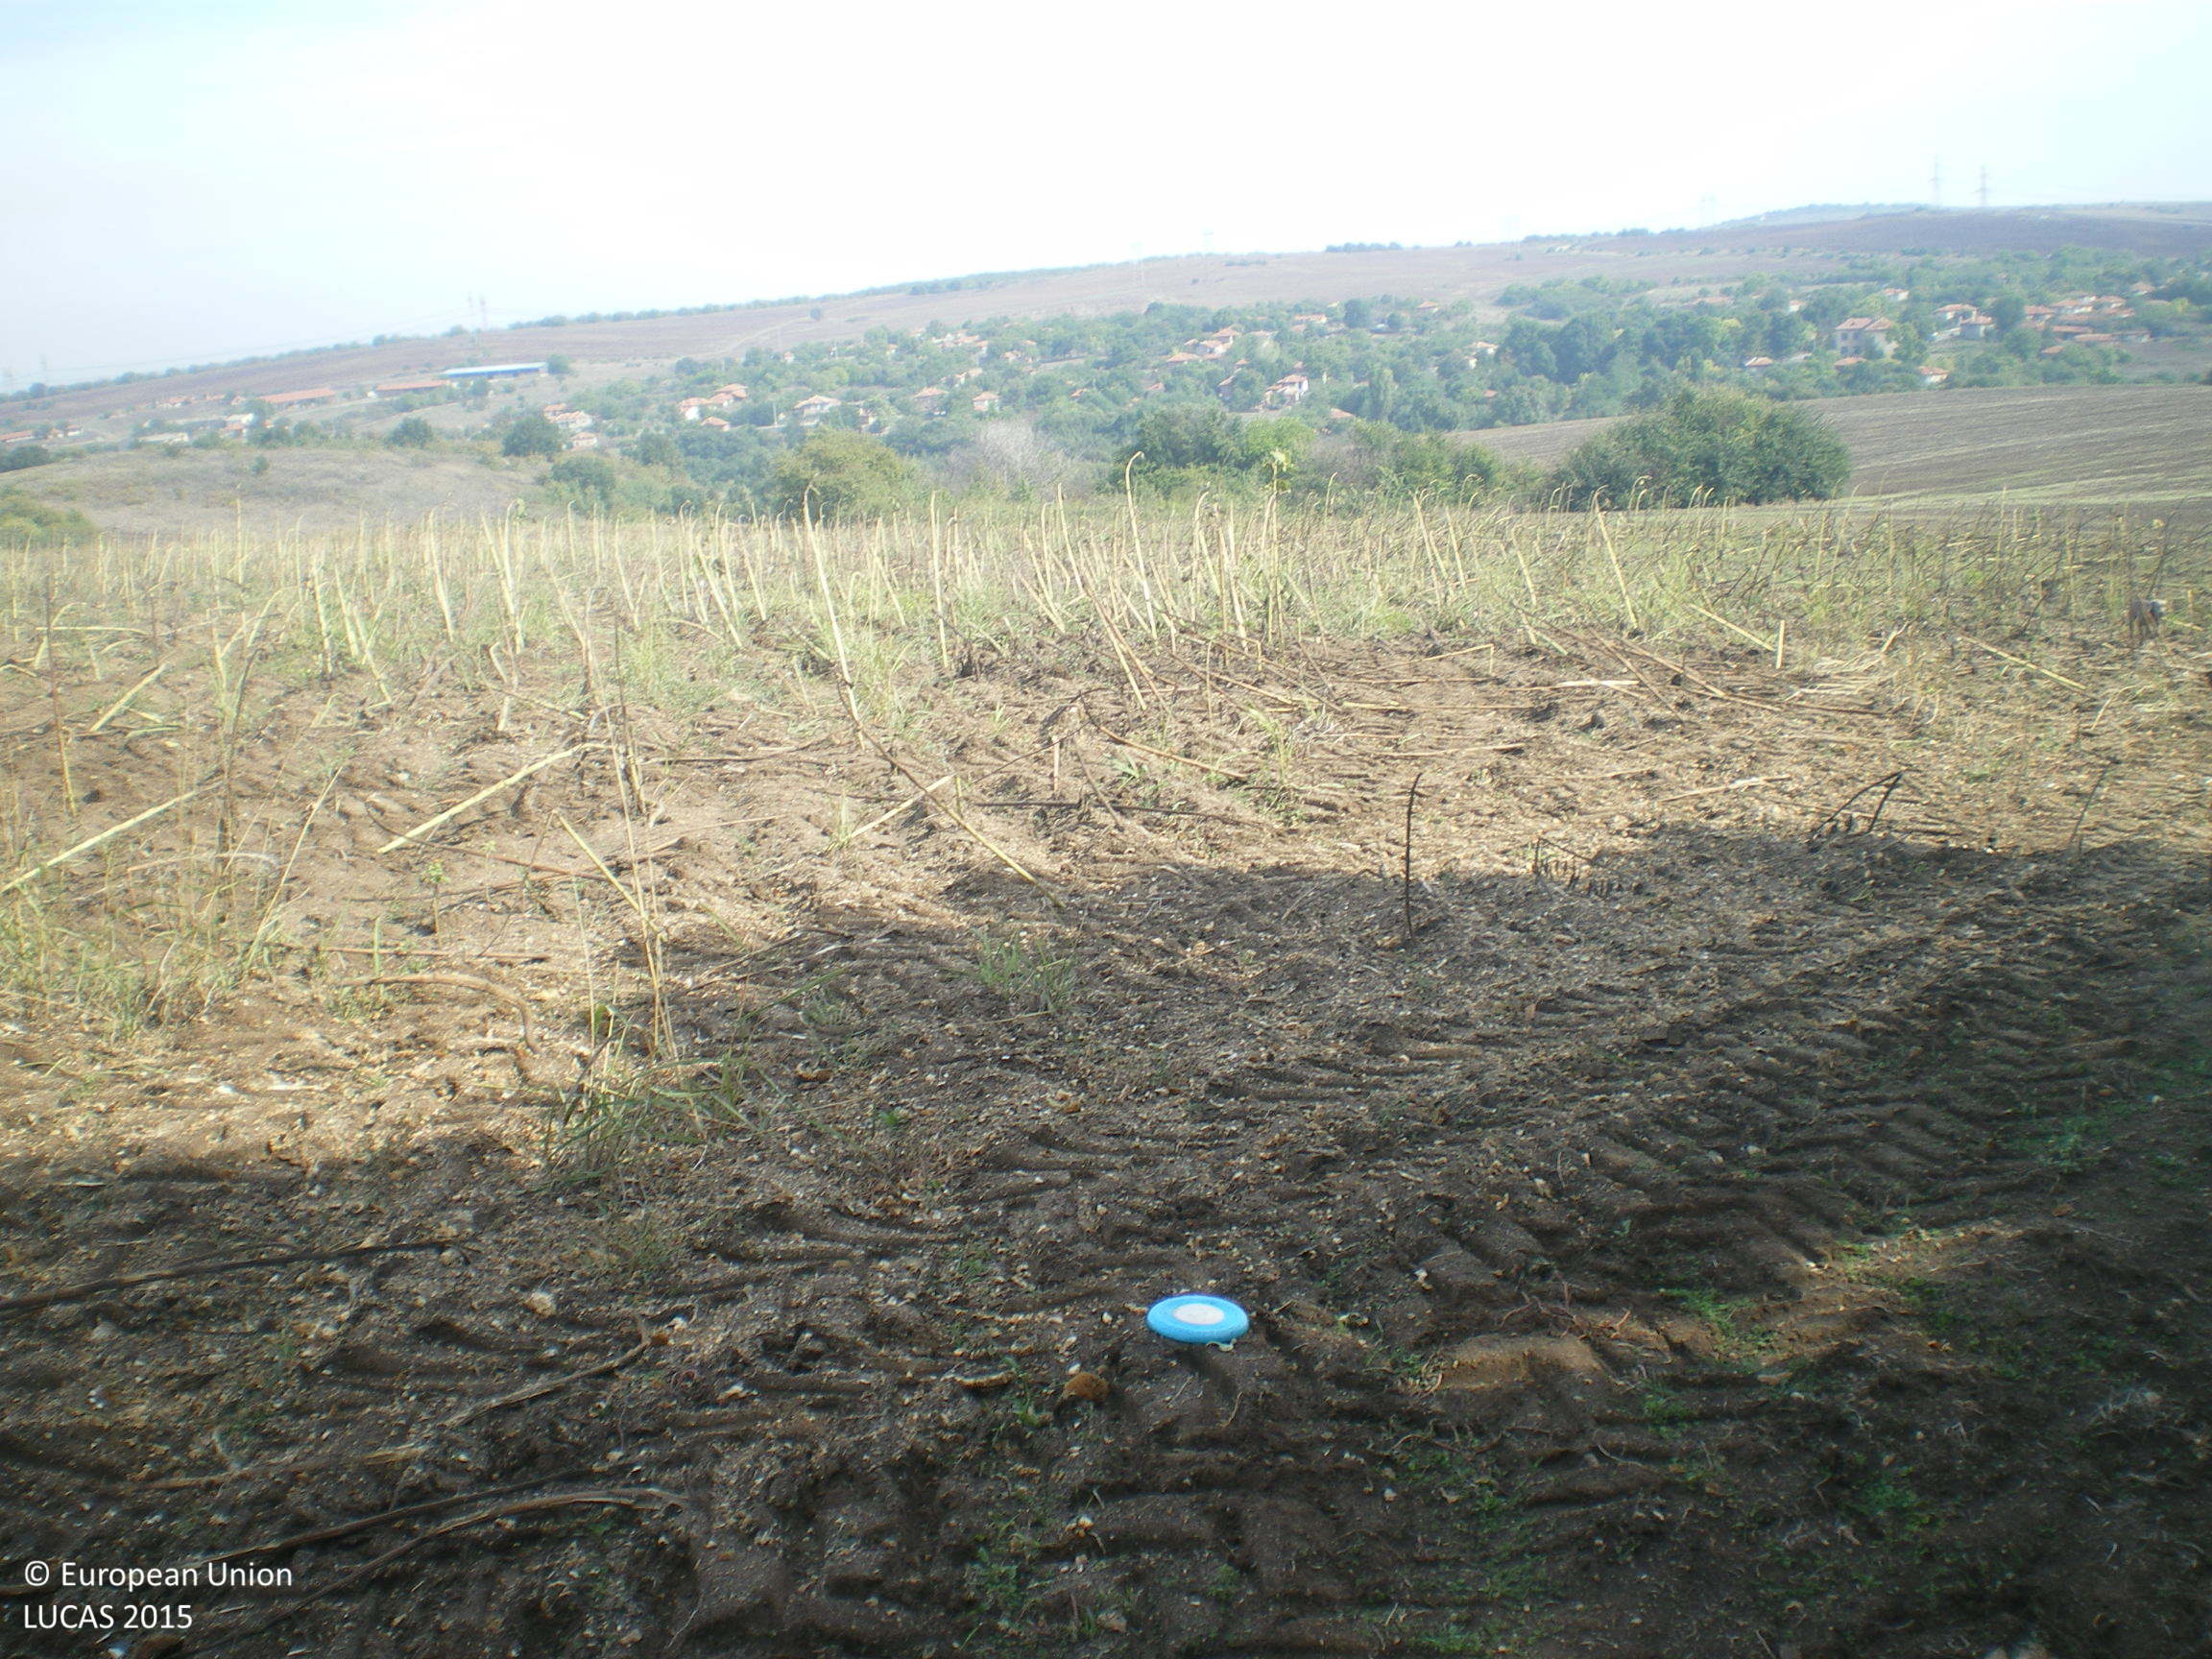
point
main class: Cropland
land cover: Sunflower
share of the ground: < 10 %
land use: Agriculture (excluding fallow land and kitchen gardens)
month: October
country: BG
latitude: 42.2111
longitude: 26.1544
